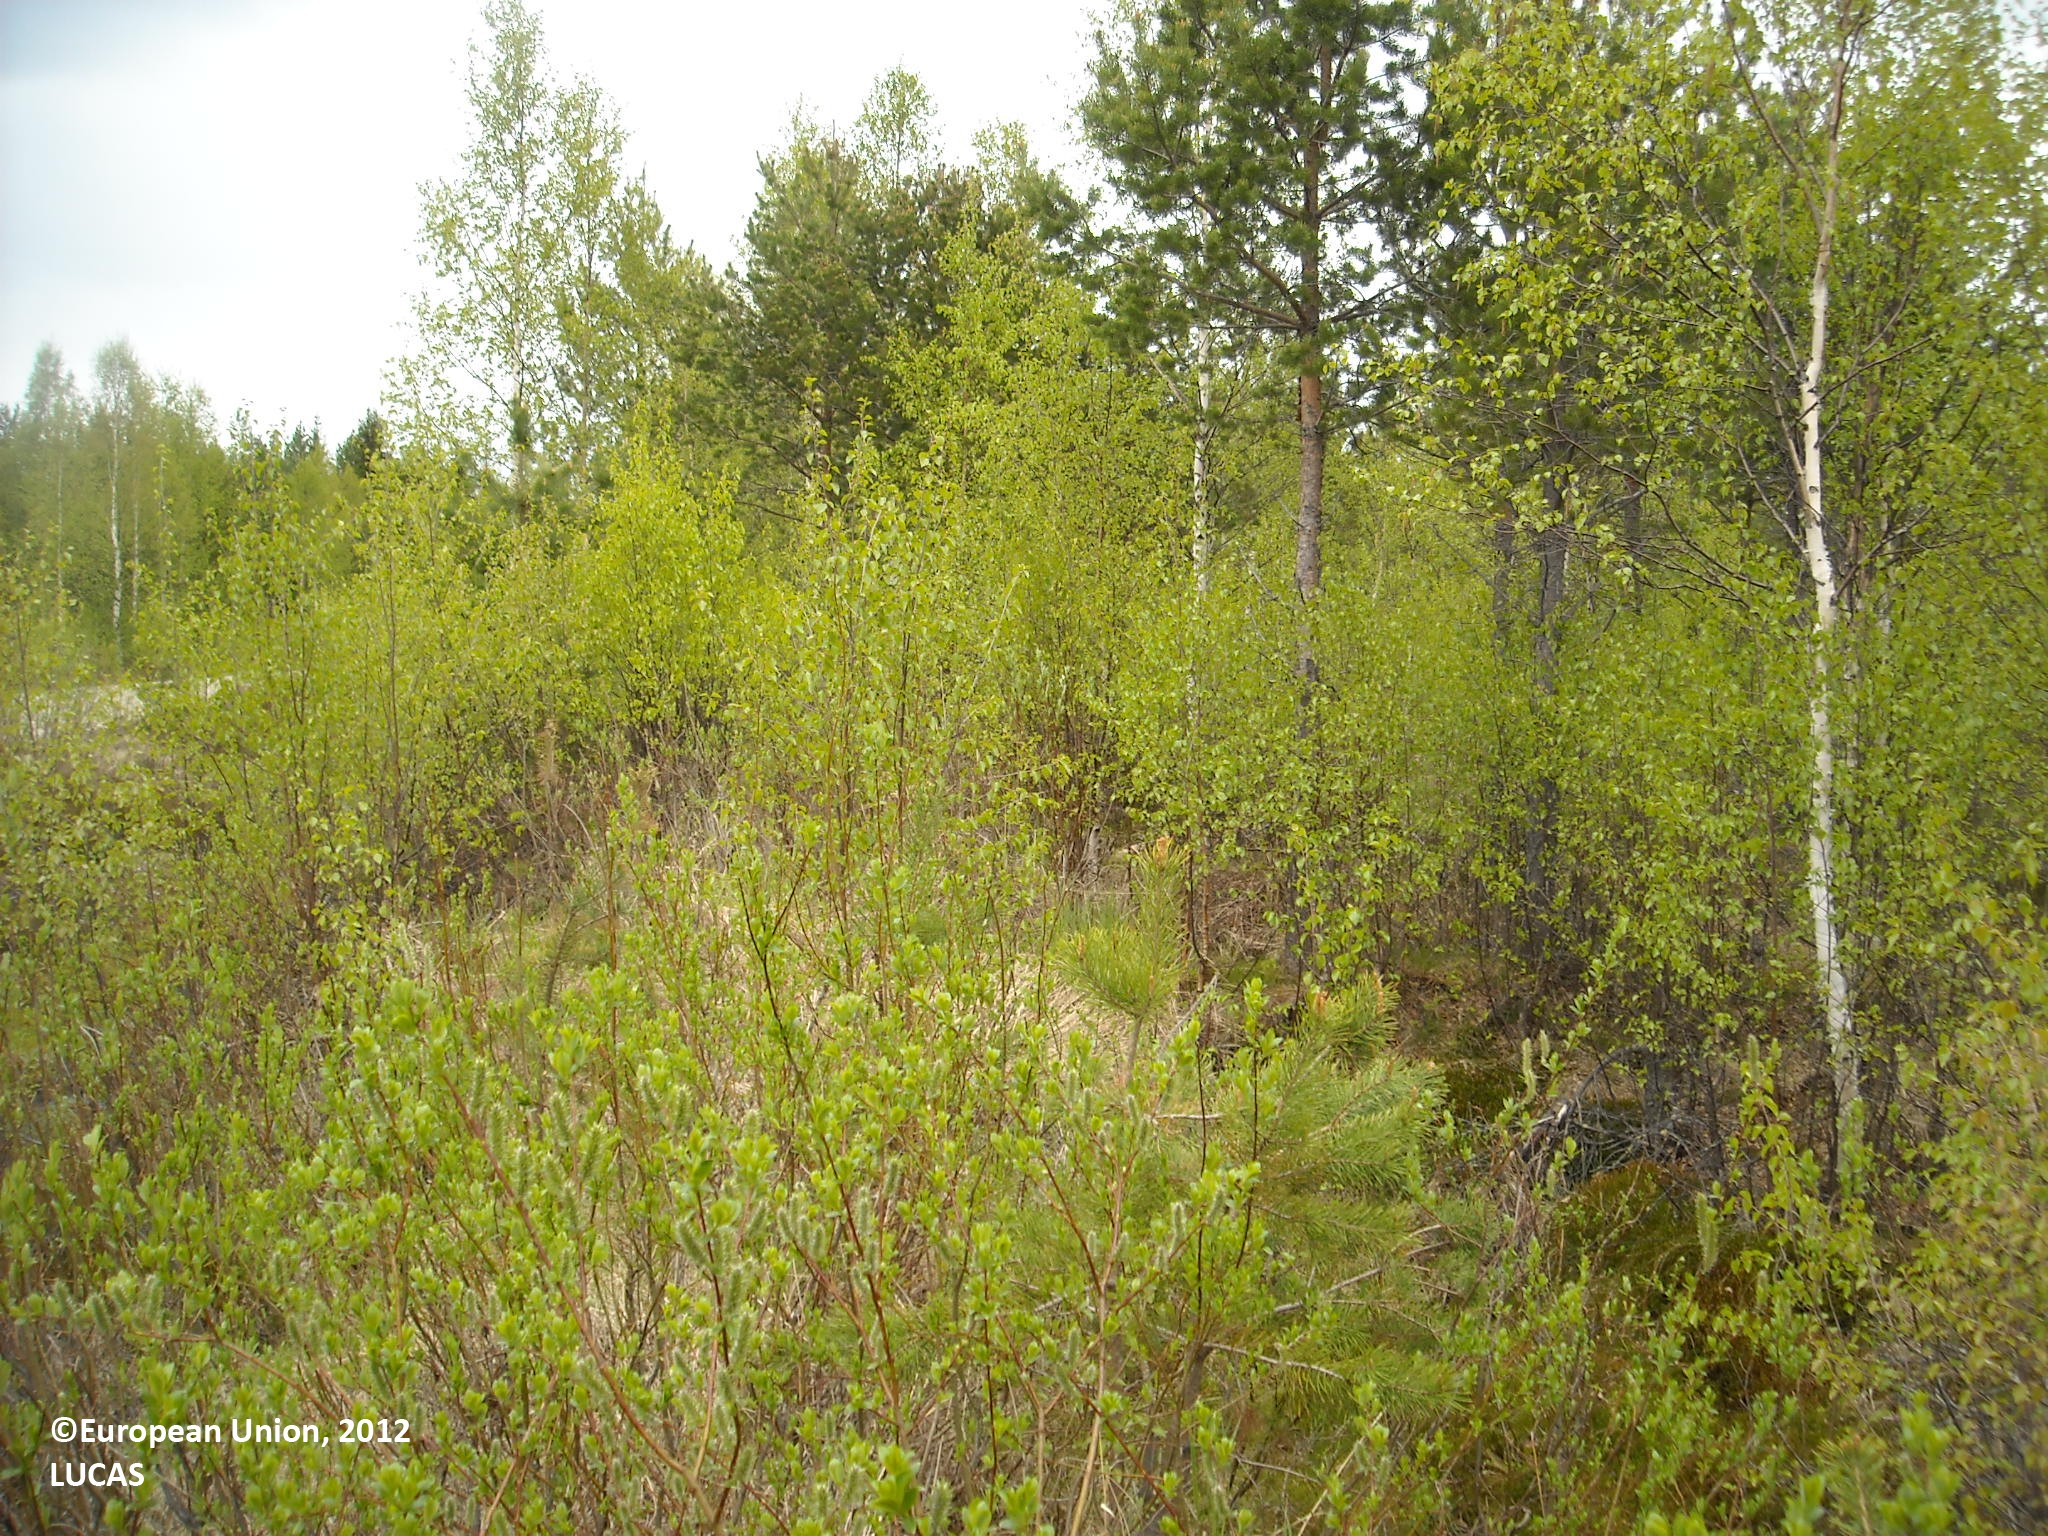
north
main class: Woodland
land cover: Pine dominated mixed woodland
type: boreal forest
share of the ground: > 75 %
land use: Forestry
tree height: > 5 m
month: June
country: FI
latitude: 64.6214
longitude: 27.3469
